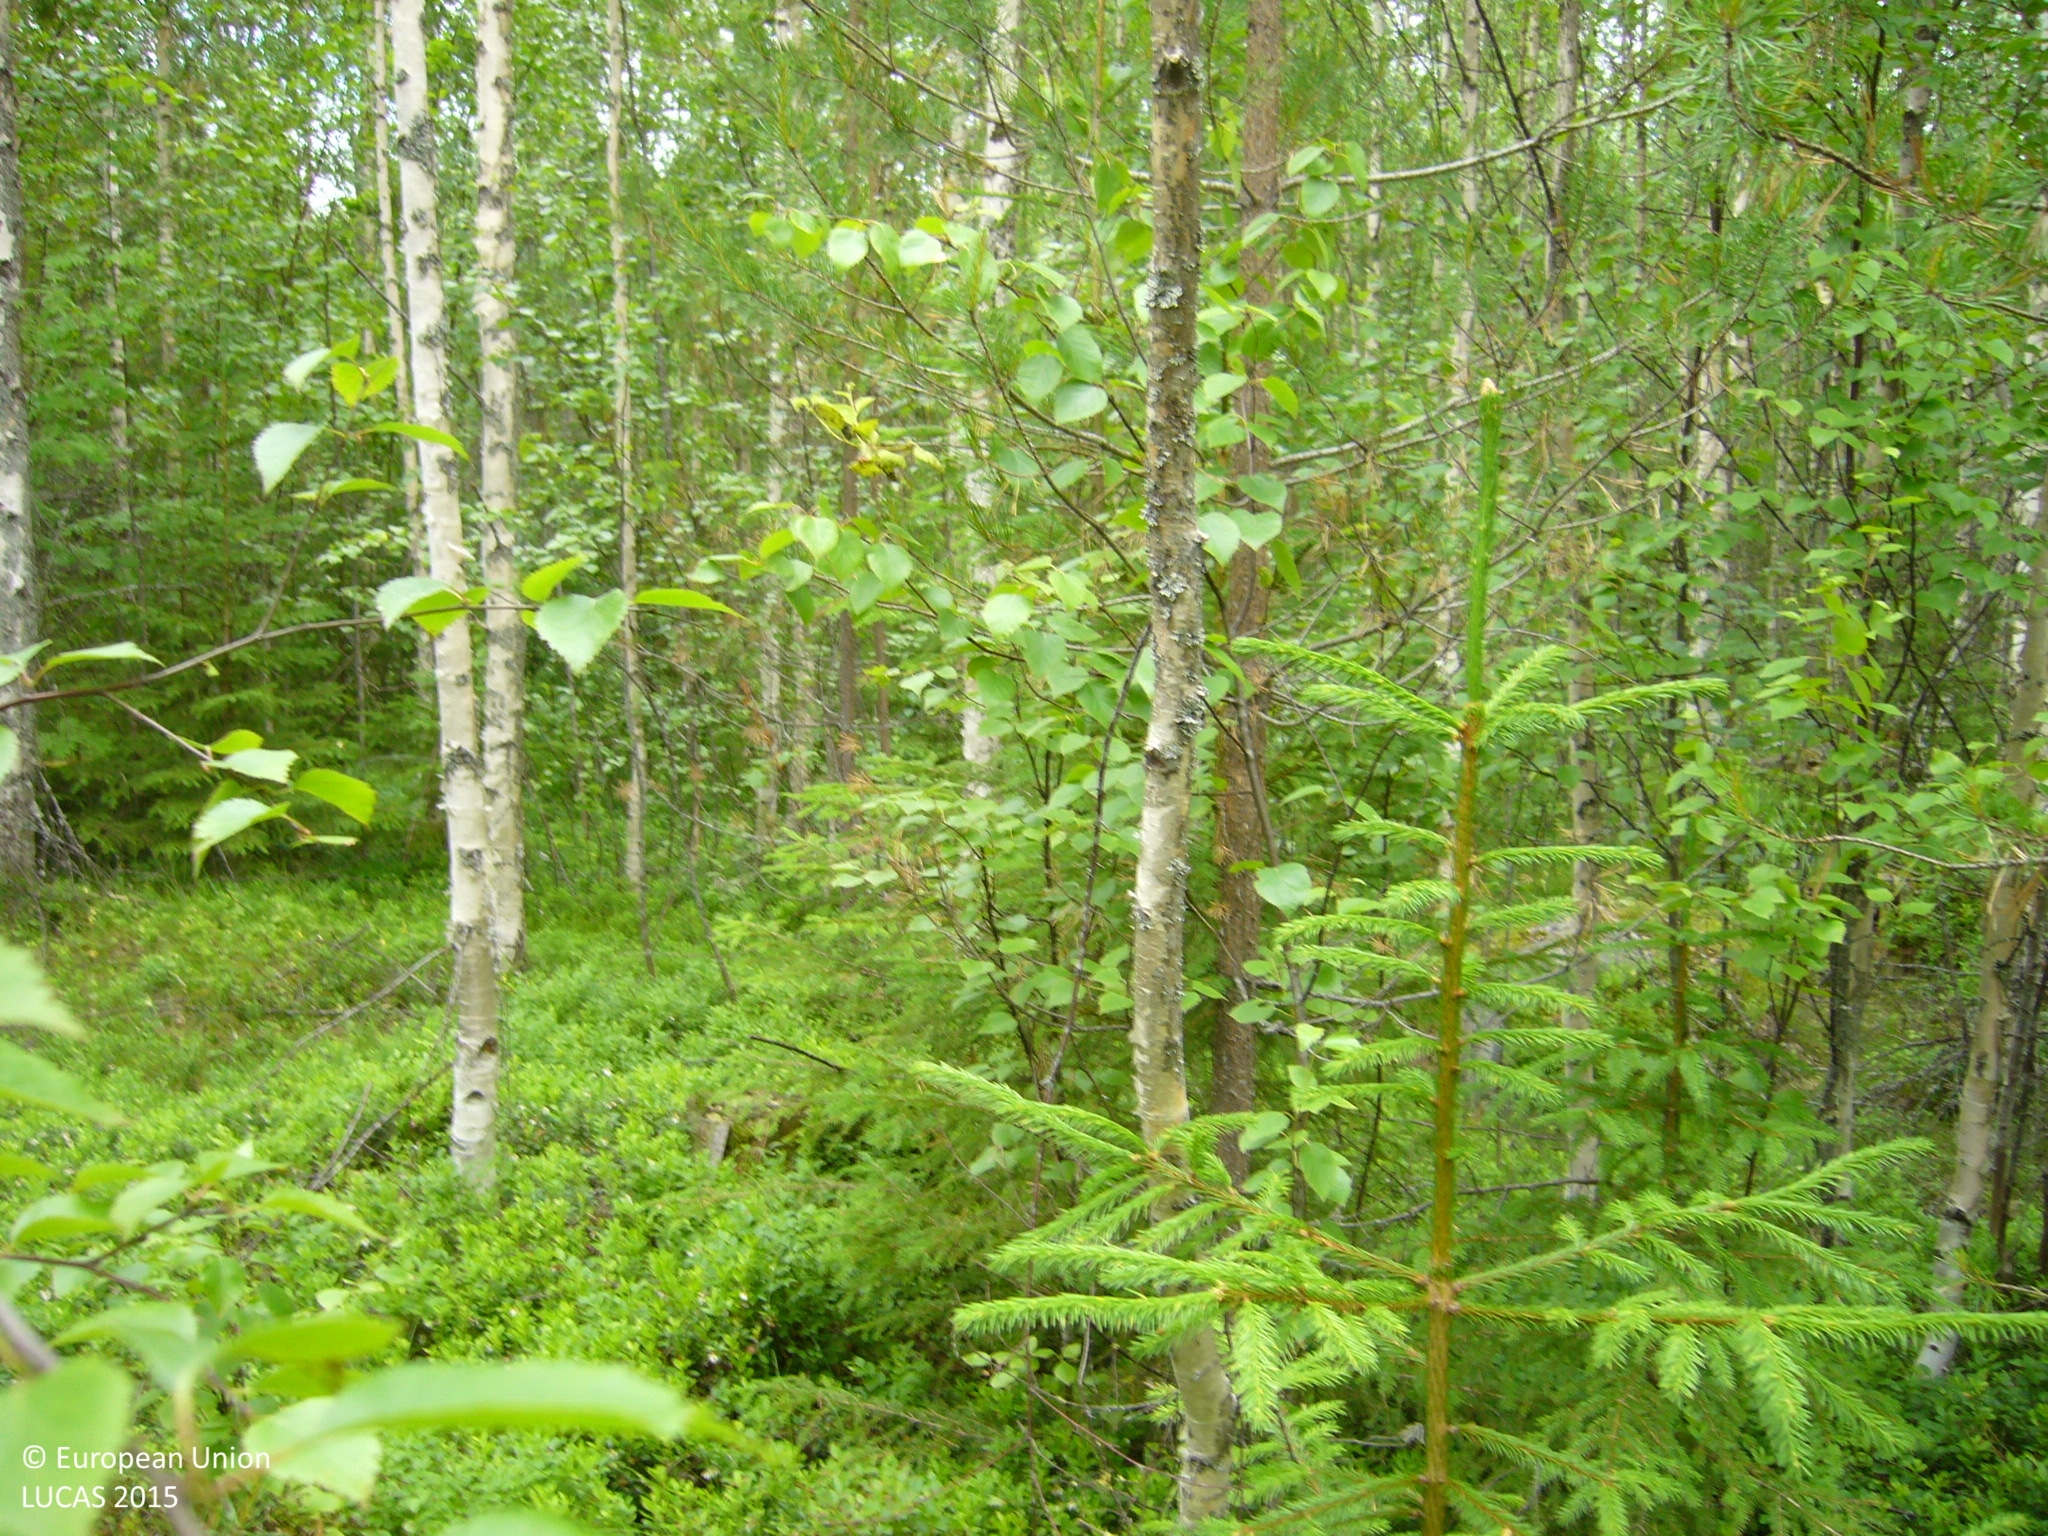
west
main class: Woodland
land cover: Pine dominated mixed woodland
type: boreal forest
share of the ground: > 75 %
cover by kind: coniferous forest trees 50 %, broadleaved forest trees 40 %, shrubs 10 %
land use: Forestry
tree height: > 5 m
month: July
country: FI
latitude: 63.1872
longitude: 26.1977
